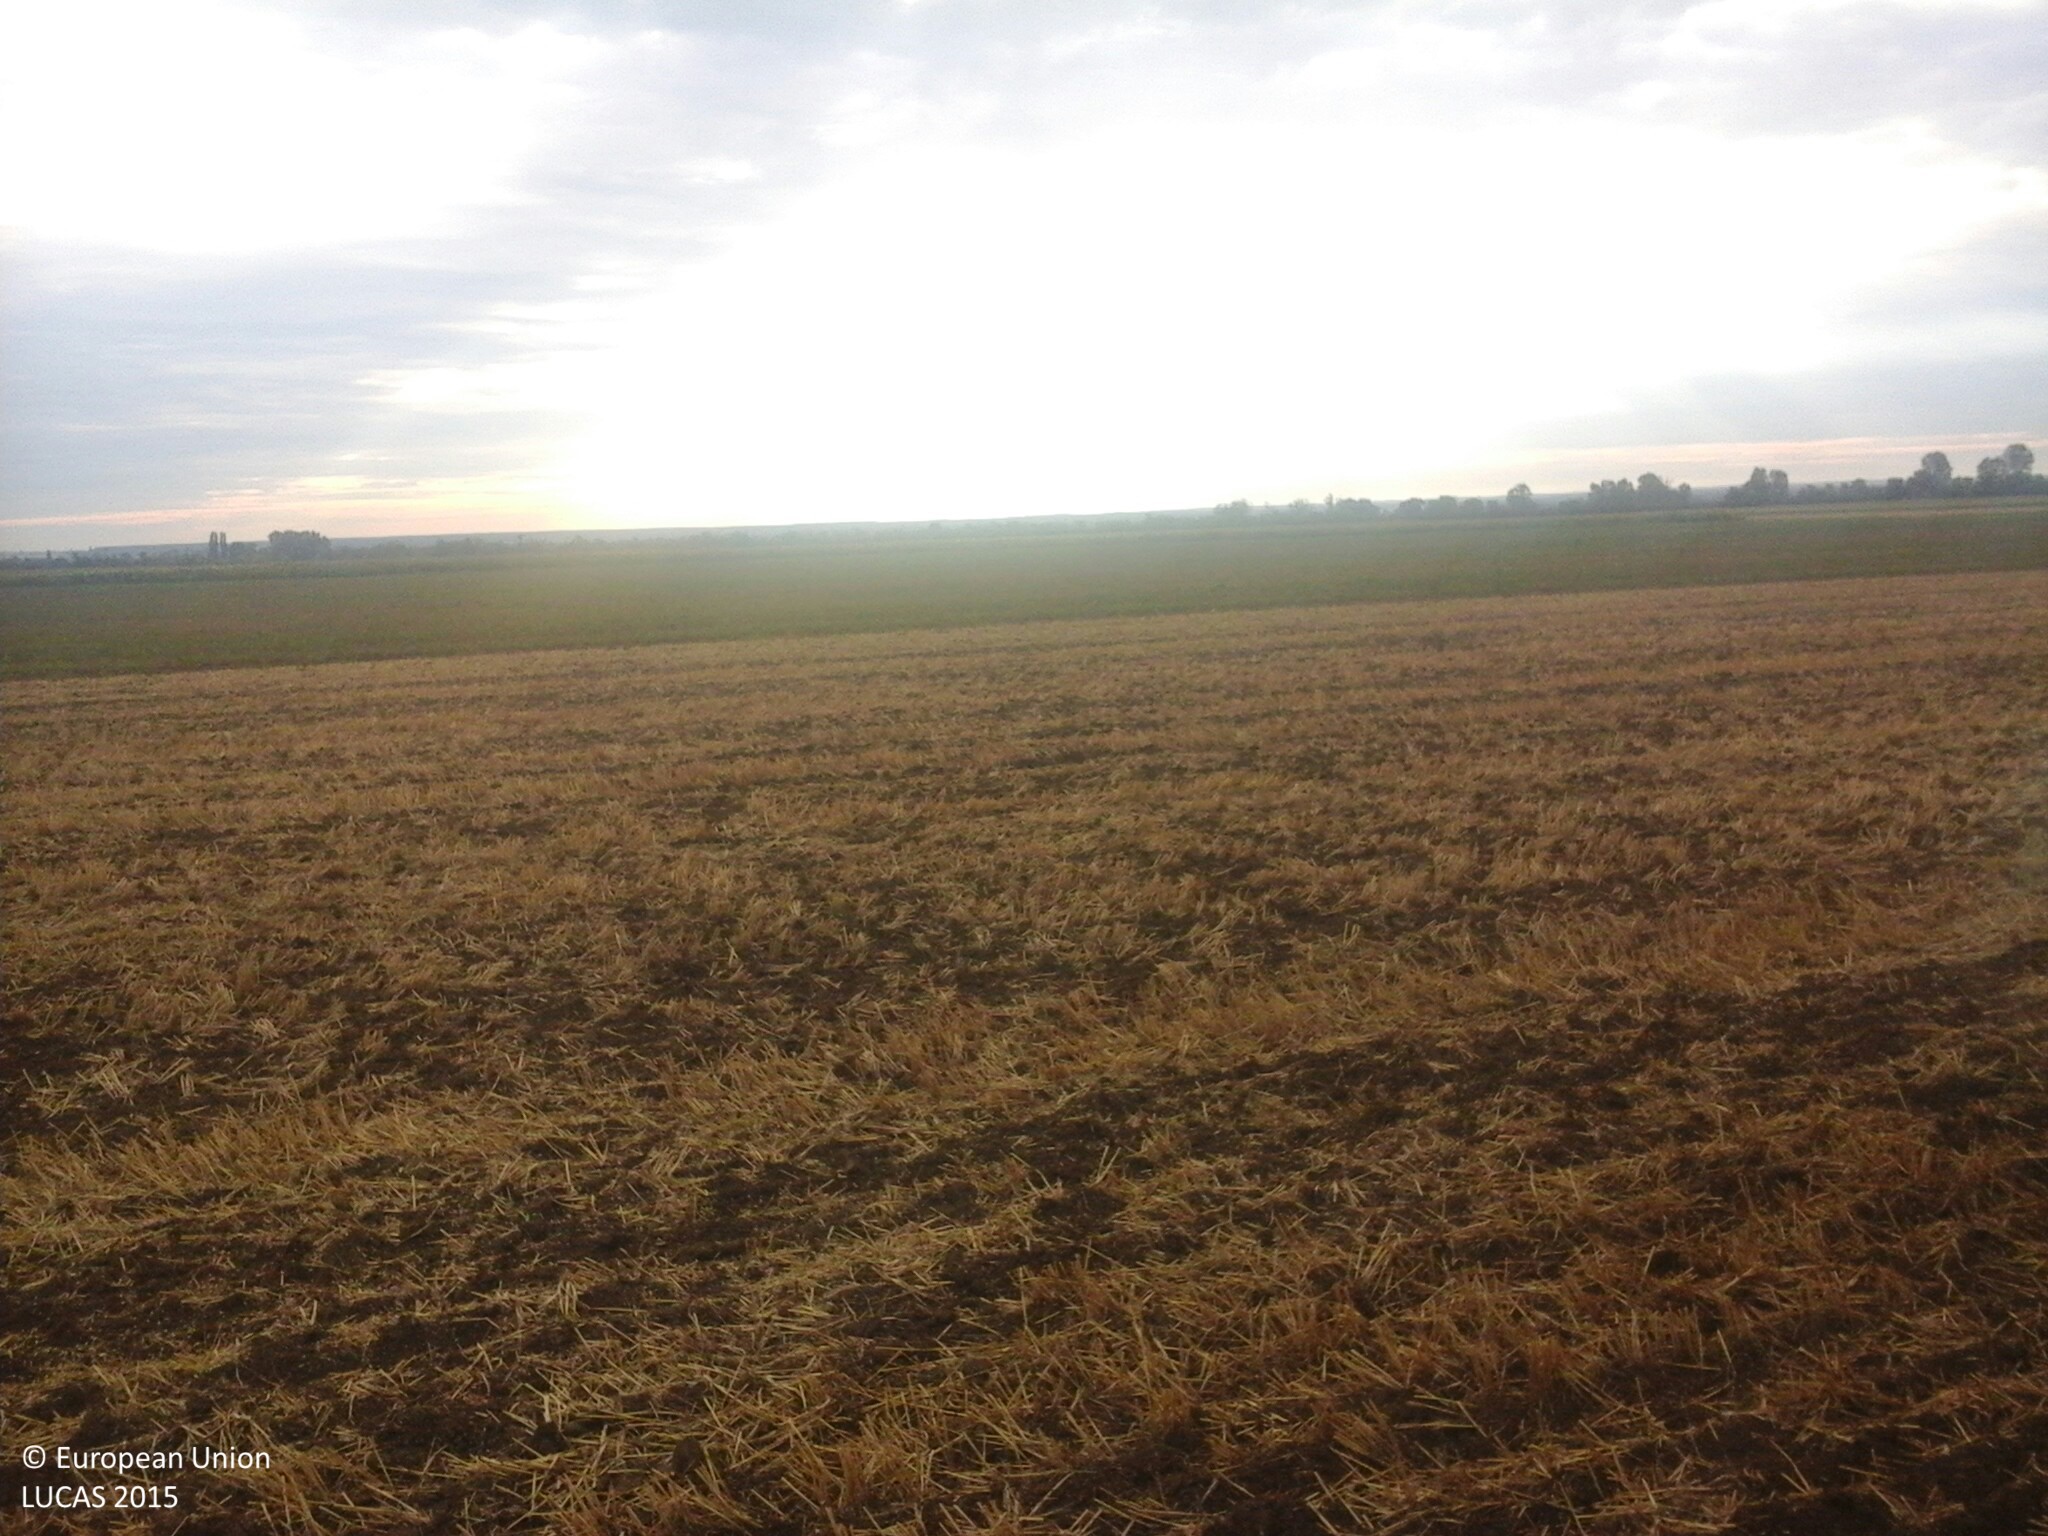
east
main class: Cropland
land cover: Oats
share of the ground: < 10 %
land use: Agriculture (excluding fallow land and kitchen gardens)
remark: Harvested field
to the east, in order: Oats; Spontaneously vegetated surfaces
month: July
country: HU
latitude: 47.0723
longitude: 18.3738
